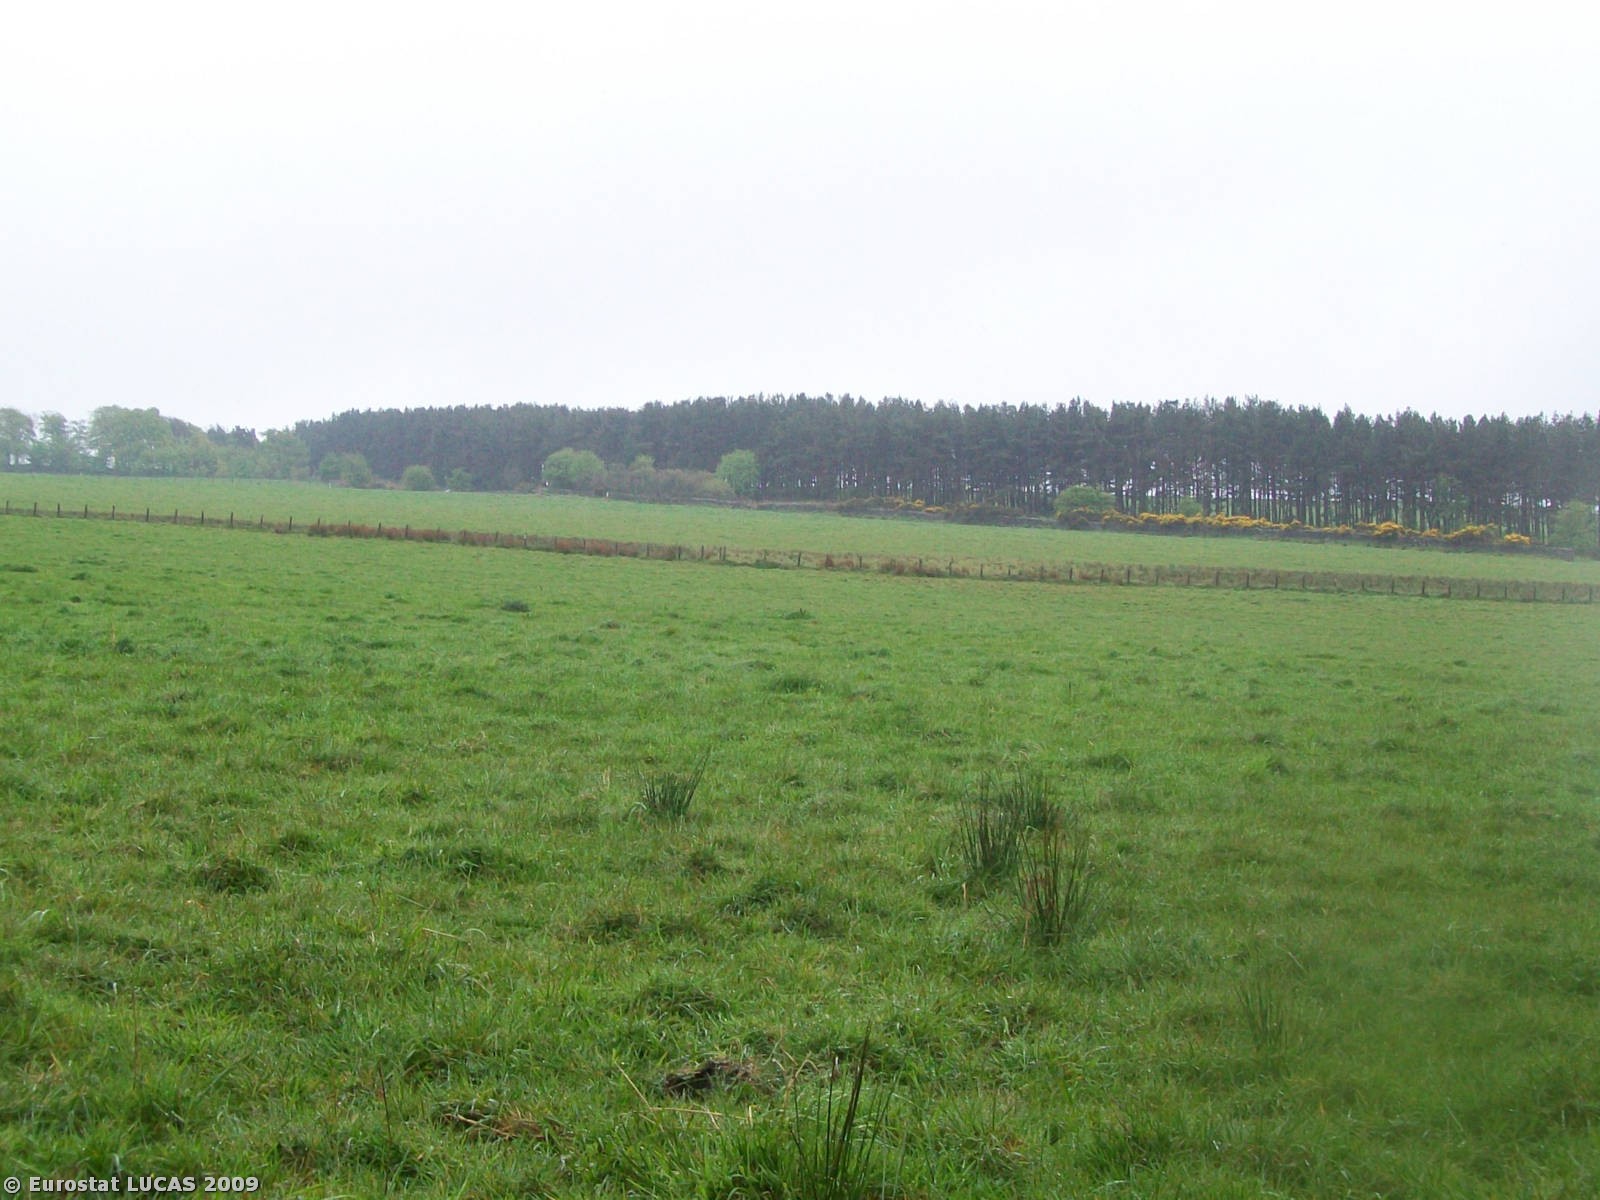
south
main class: Woodland
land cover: Broadleaved woodland
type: mesophytic deciduous forest
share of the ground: > 75 %
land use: Unused
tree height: > 5 m
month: May
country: GB
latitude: 54.8960
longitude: -1.9829
